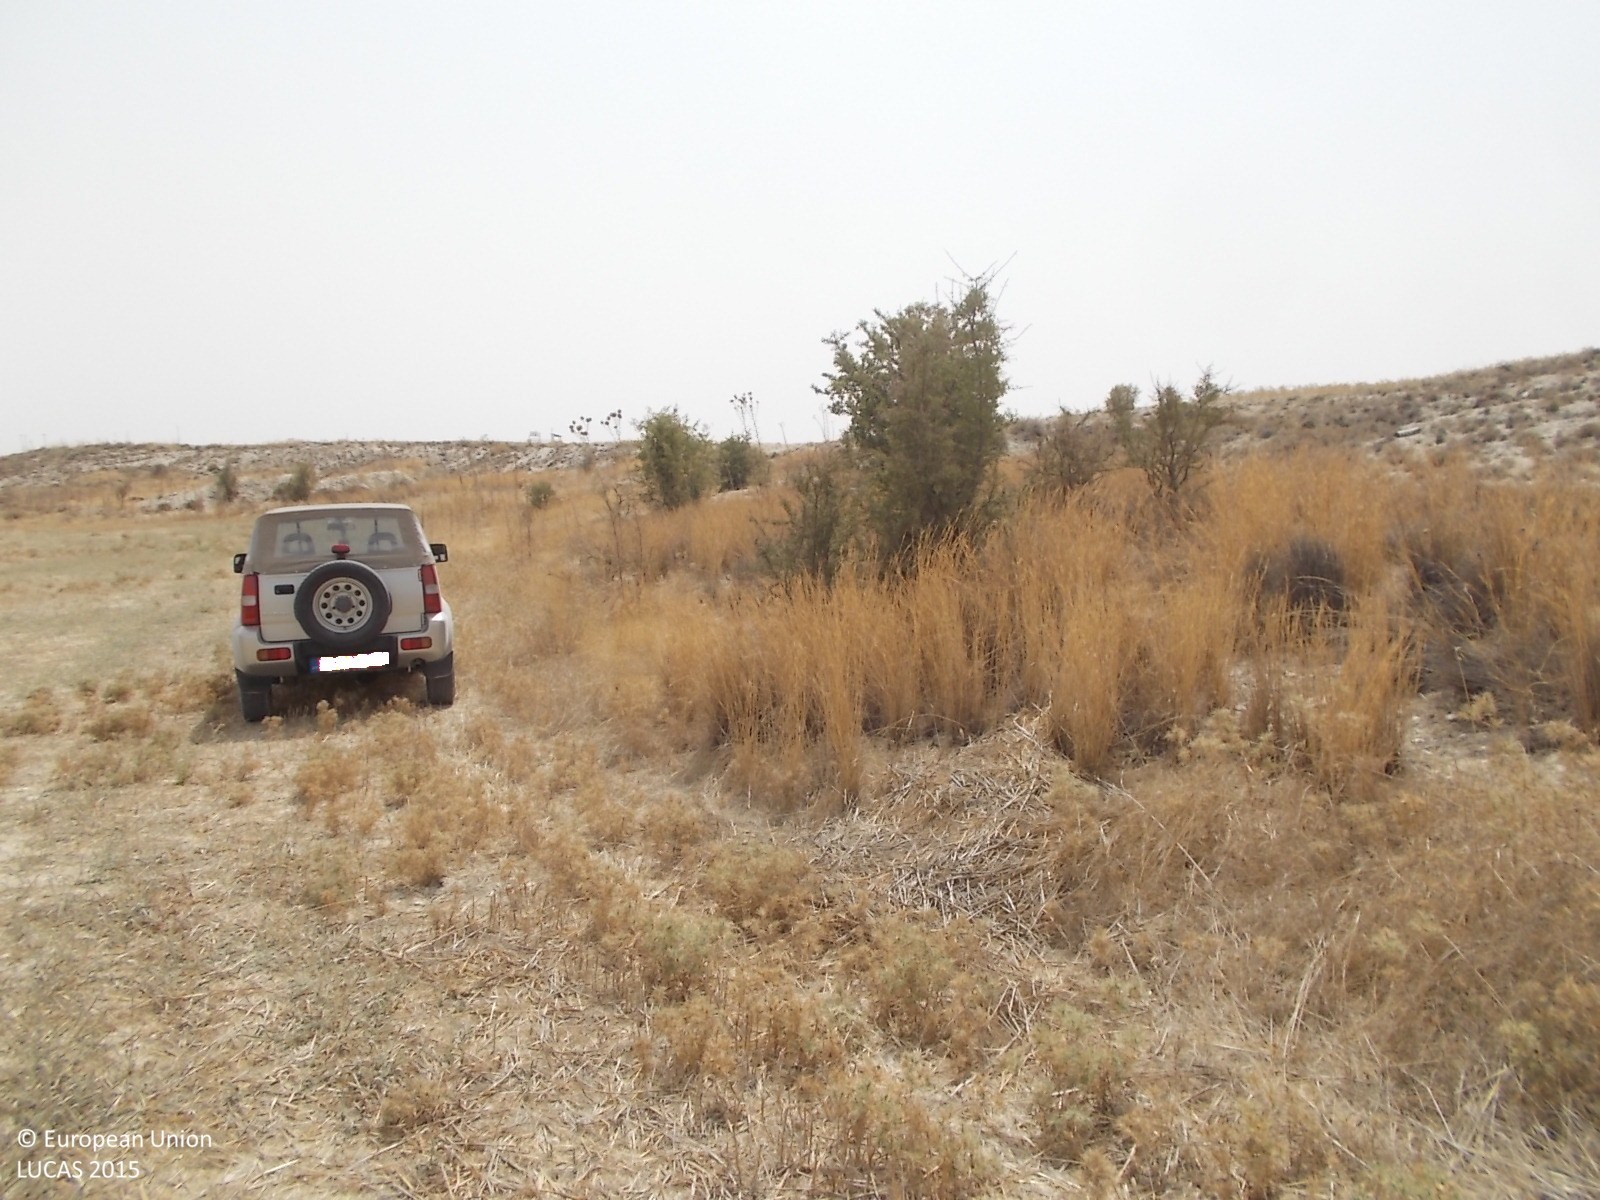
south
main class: Cropland
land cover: Mixed cereals for fodder
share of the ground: < 10 %
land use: Agriculture (excluding fallow land and kitchen gardens)
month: April
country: CY
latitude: 34.9225
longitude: 33.5189
